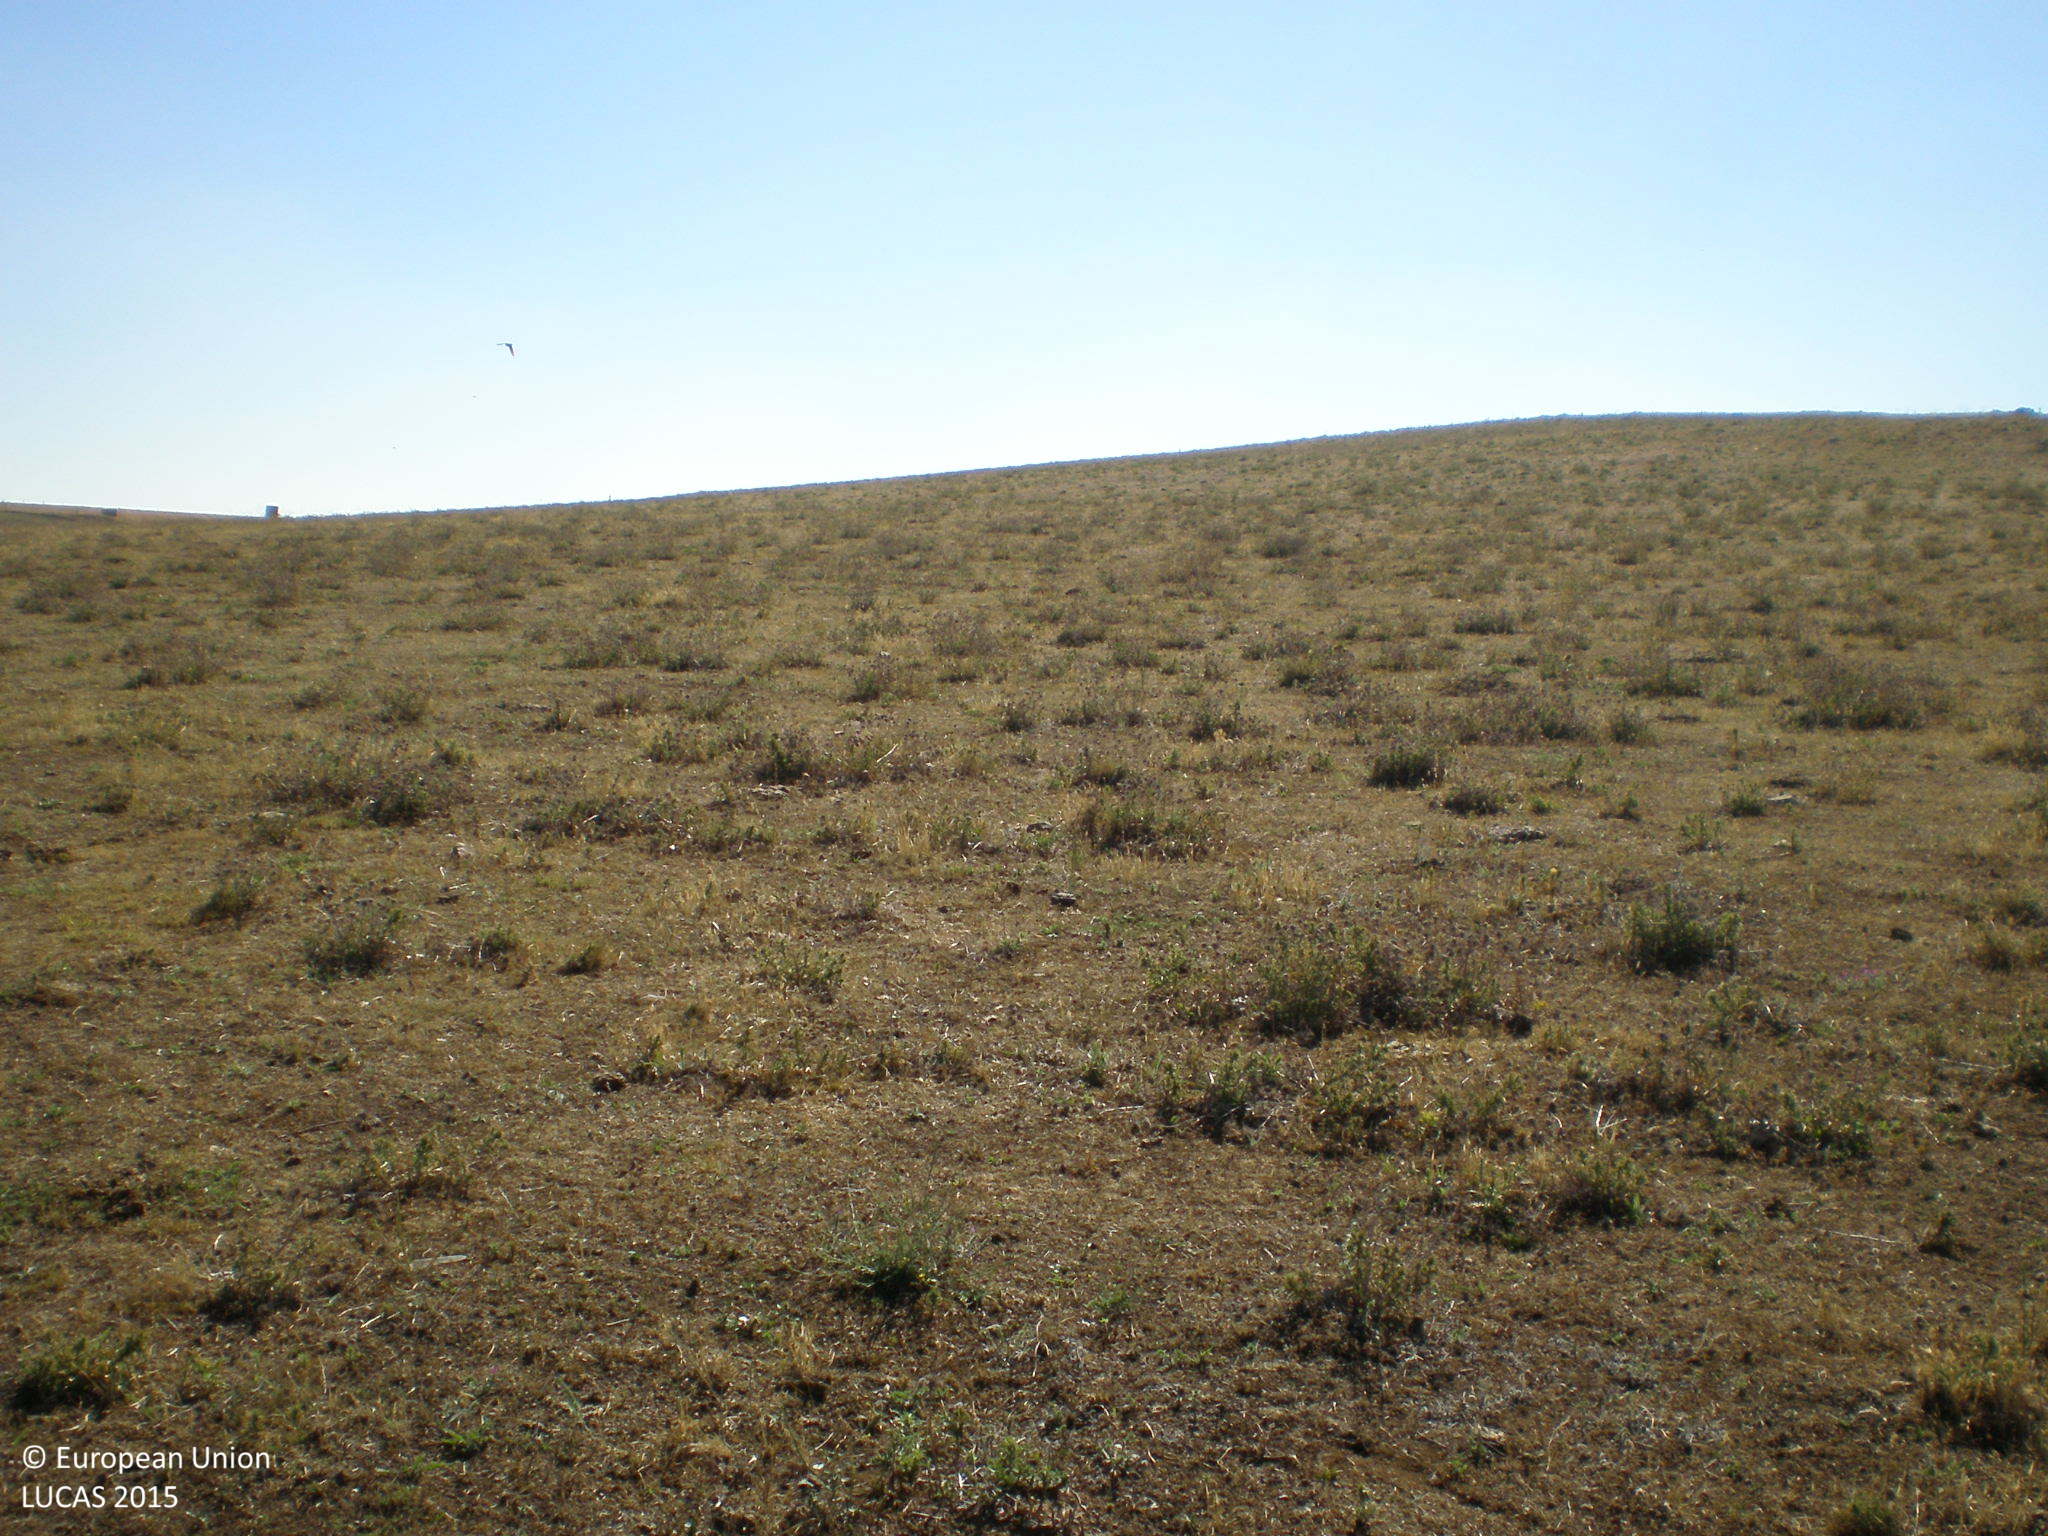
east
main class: Grassland
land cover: Grassland without tree/shrub cover
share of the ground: > 75 %
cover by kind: herbaceous plants 100 %
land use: Agriculture (excluding fallow land and kitchen gardens)
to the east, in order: Grassland without tree/shrub cover
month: June
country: ES
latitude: 40.8906
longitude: -5.6841
